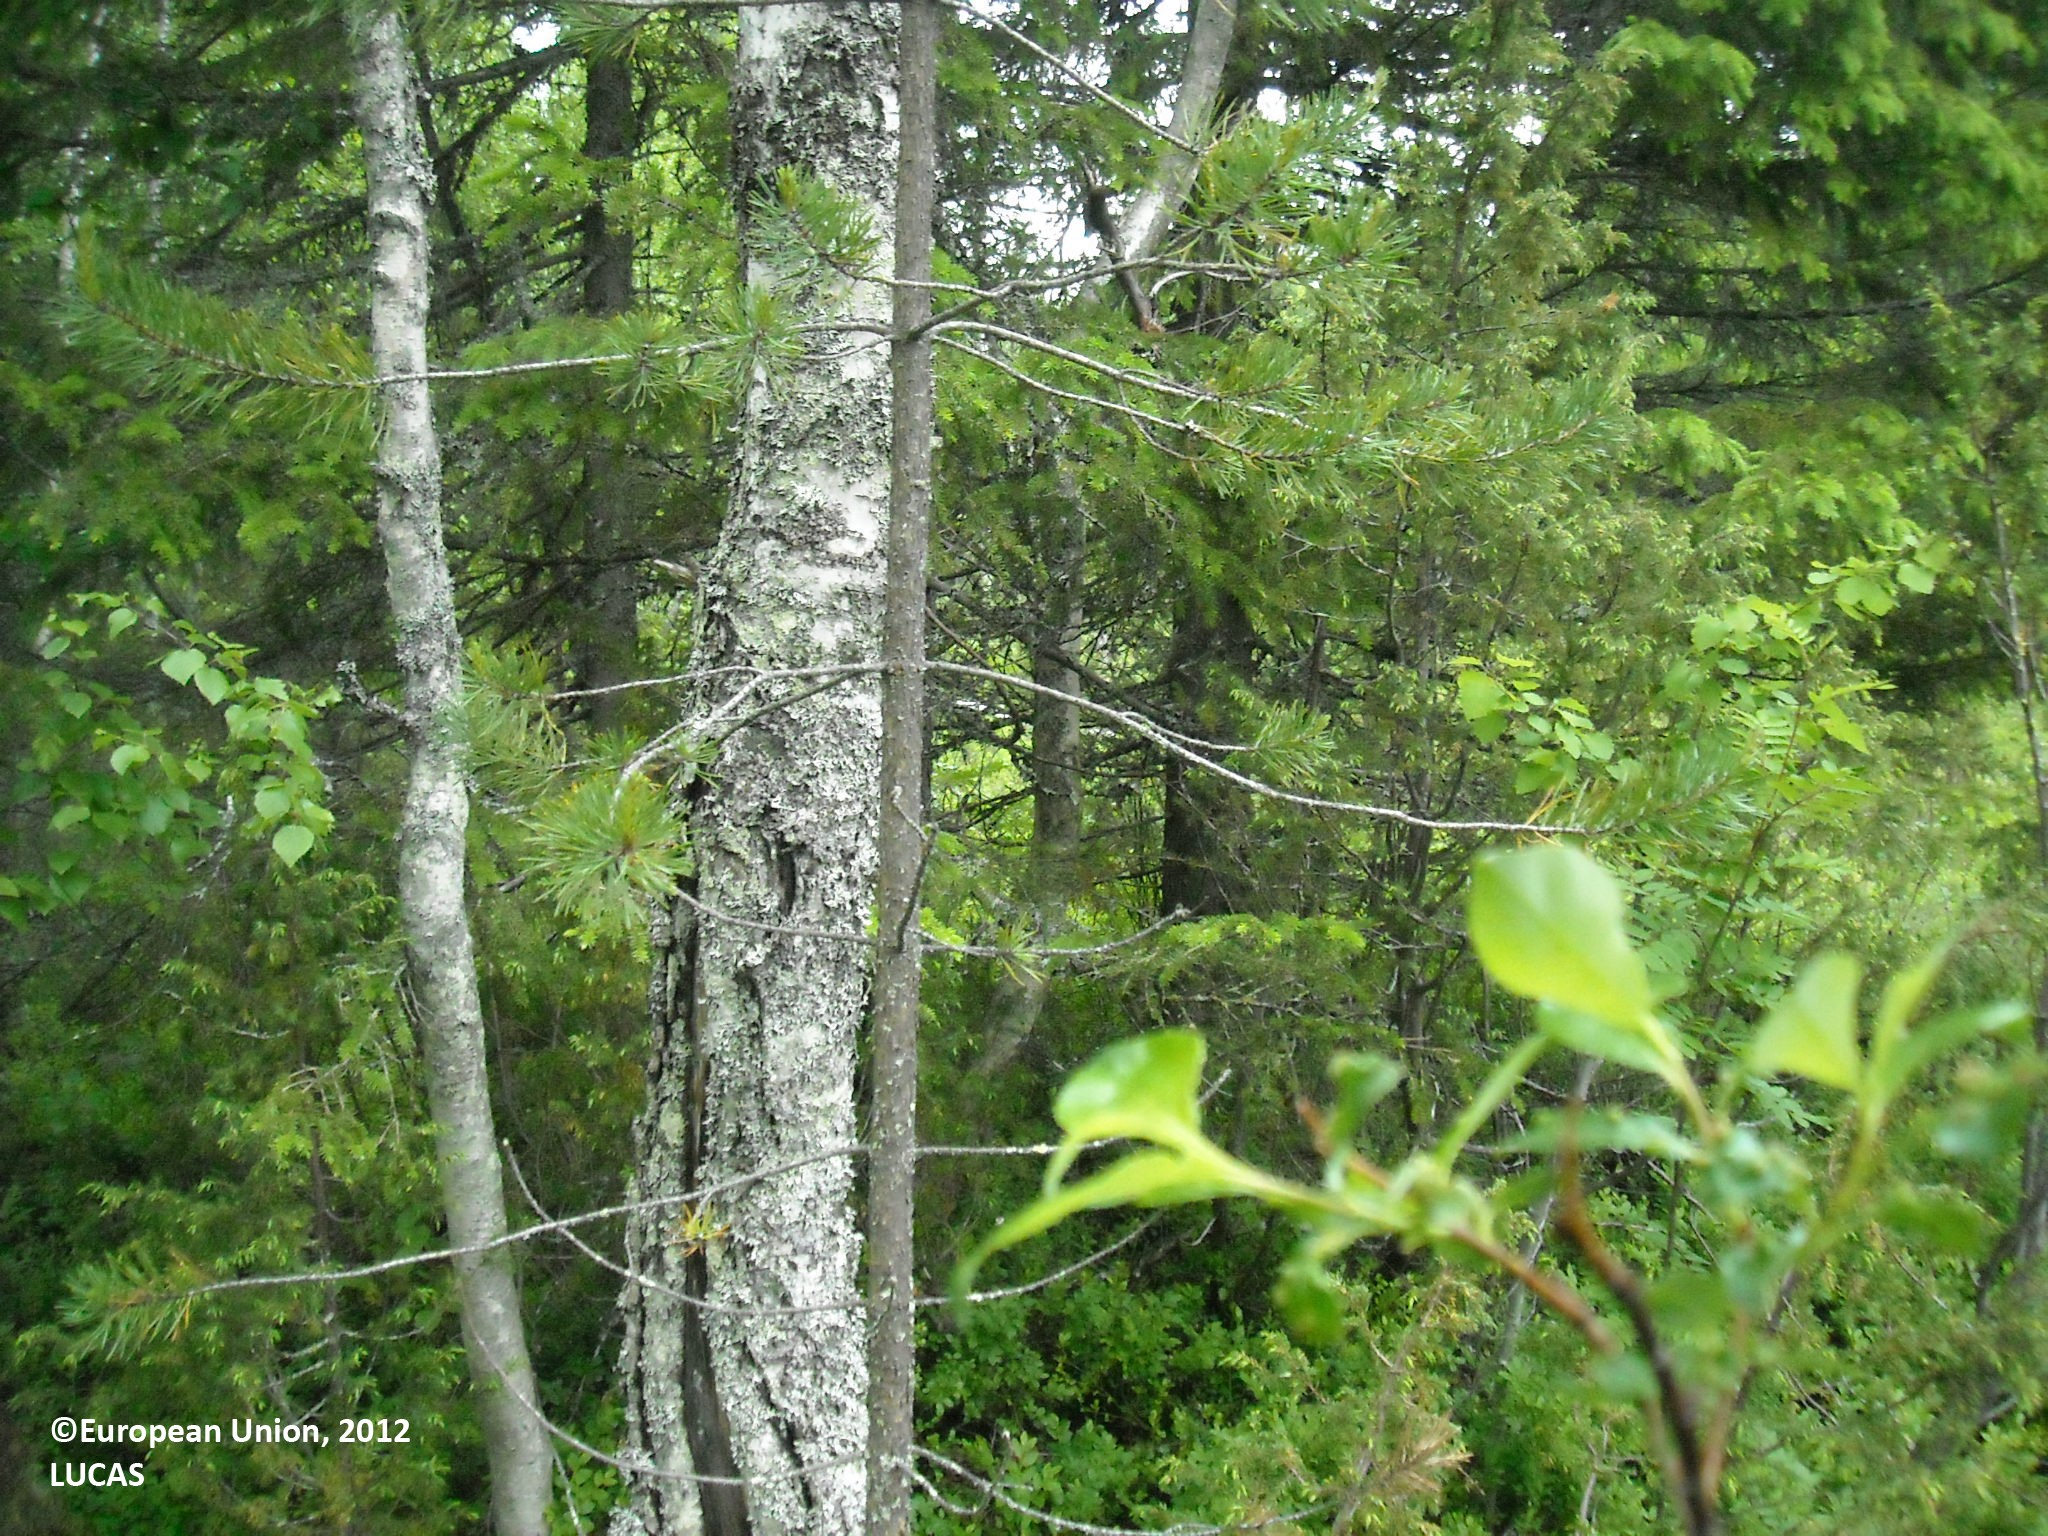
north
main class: Woodland
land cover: Spruce dominated mixed woodland
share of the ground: > 75 %
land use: Forestry
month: July
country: FI
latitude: 64.9894
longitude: 27.8917
